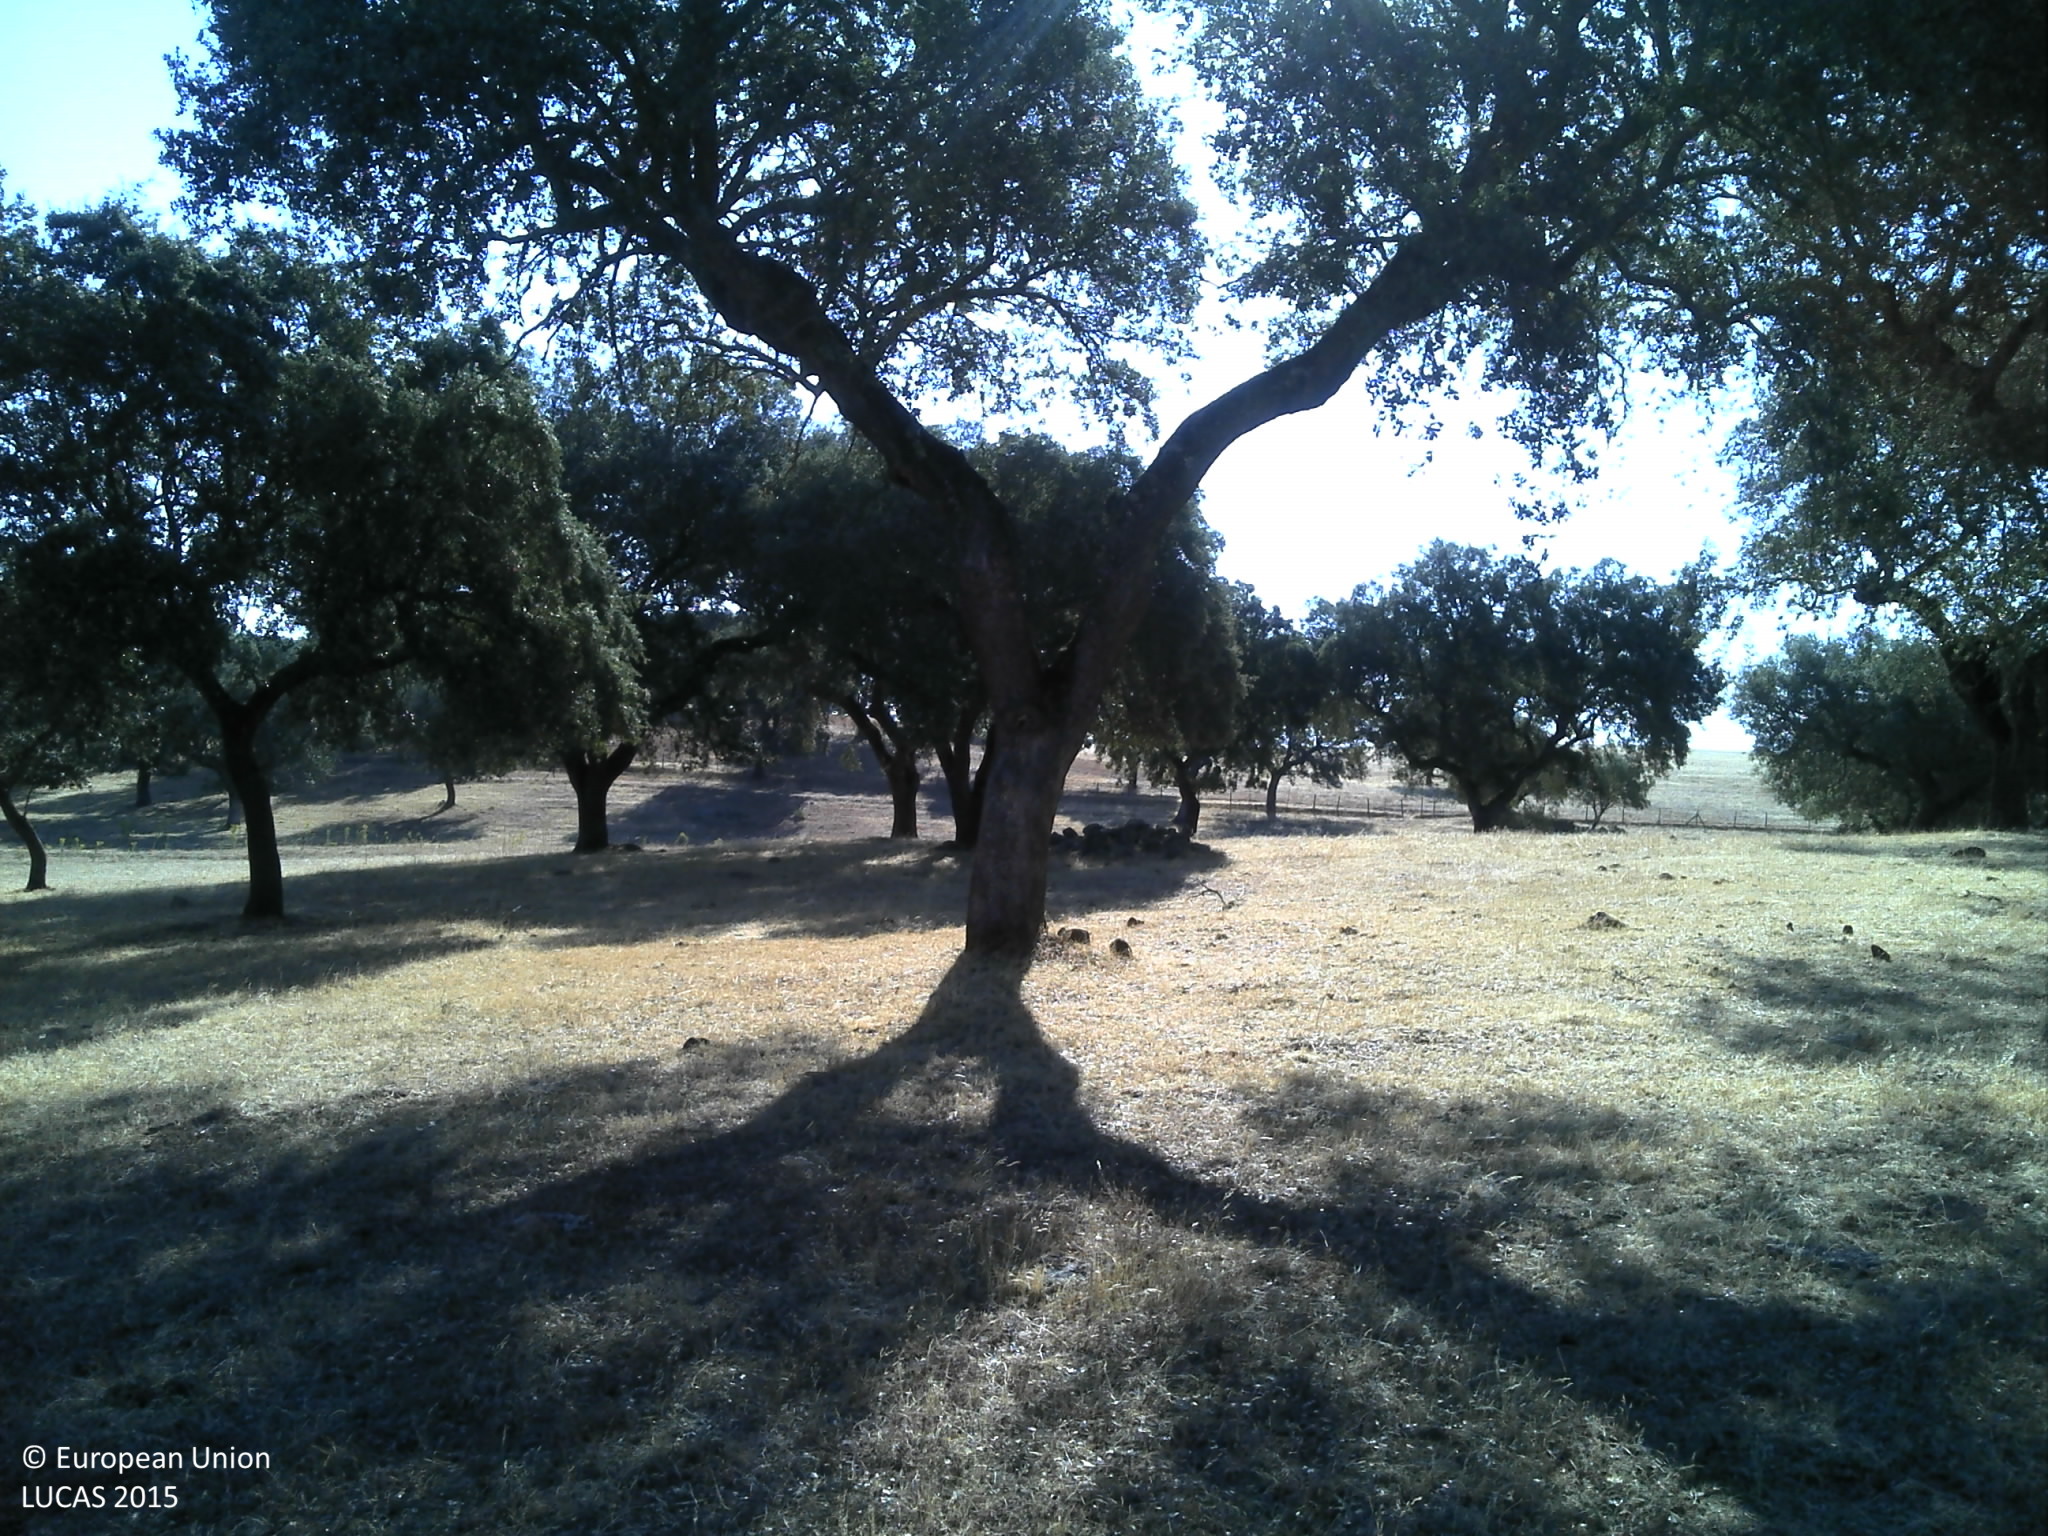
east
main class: Woodland
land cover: Broadleaved woodland
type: broadleaved evergreen forest
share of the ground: 25 - 50 %
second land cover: Grassland without tree/shrub cover
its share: 25 - 50 %
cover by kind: unconsolidated bare surface 50 %, broadleaved forest trees 25 %, herbaceous plants 25 %
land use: Forestry
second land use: Agriculture (excluding fallow land and kitchen gardens)
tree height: > 5 m
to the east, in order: Broadleaved woodland; Grassland without tree/shrub cover; Broadleaved woodland; Grassland without tree/shrub cover; Rivers and streams; Broadleaved woodland; Fences; Broadleaved woodland; Grassland without tree/shrub cover; Grassland with sparse tree/shrub cover; Grassland without tree/shrub cover
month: July
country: PT
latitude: 39.0316
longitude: -7.3984
